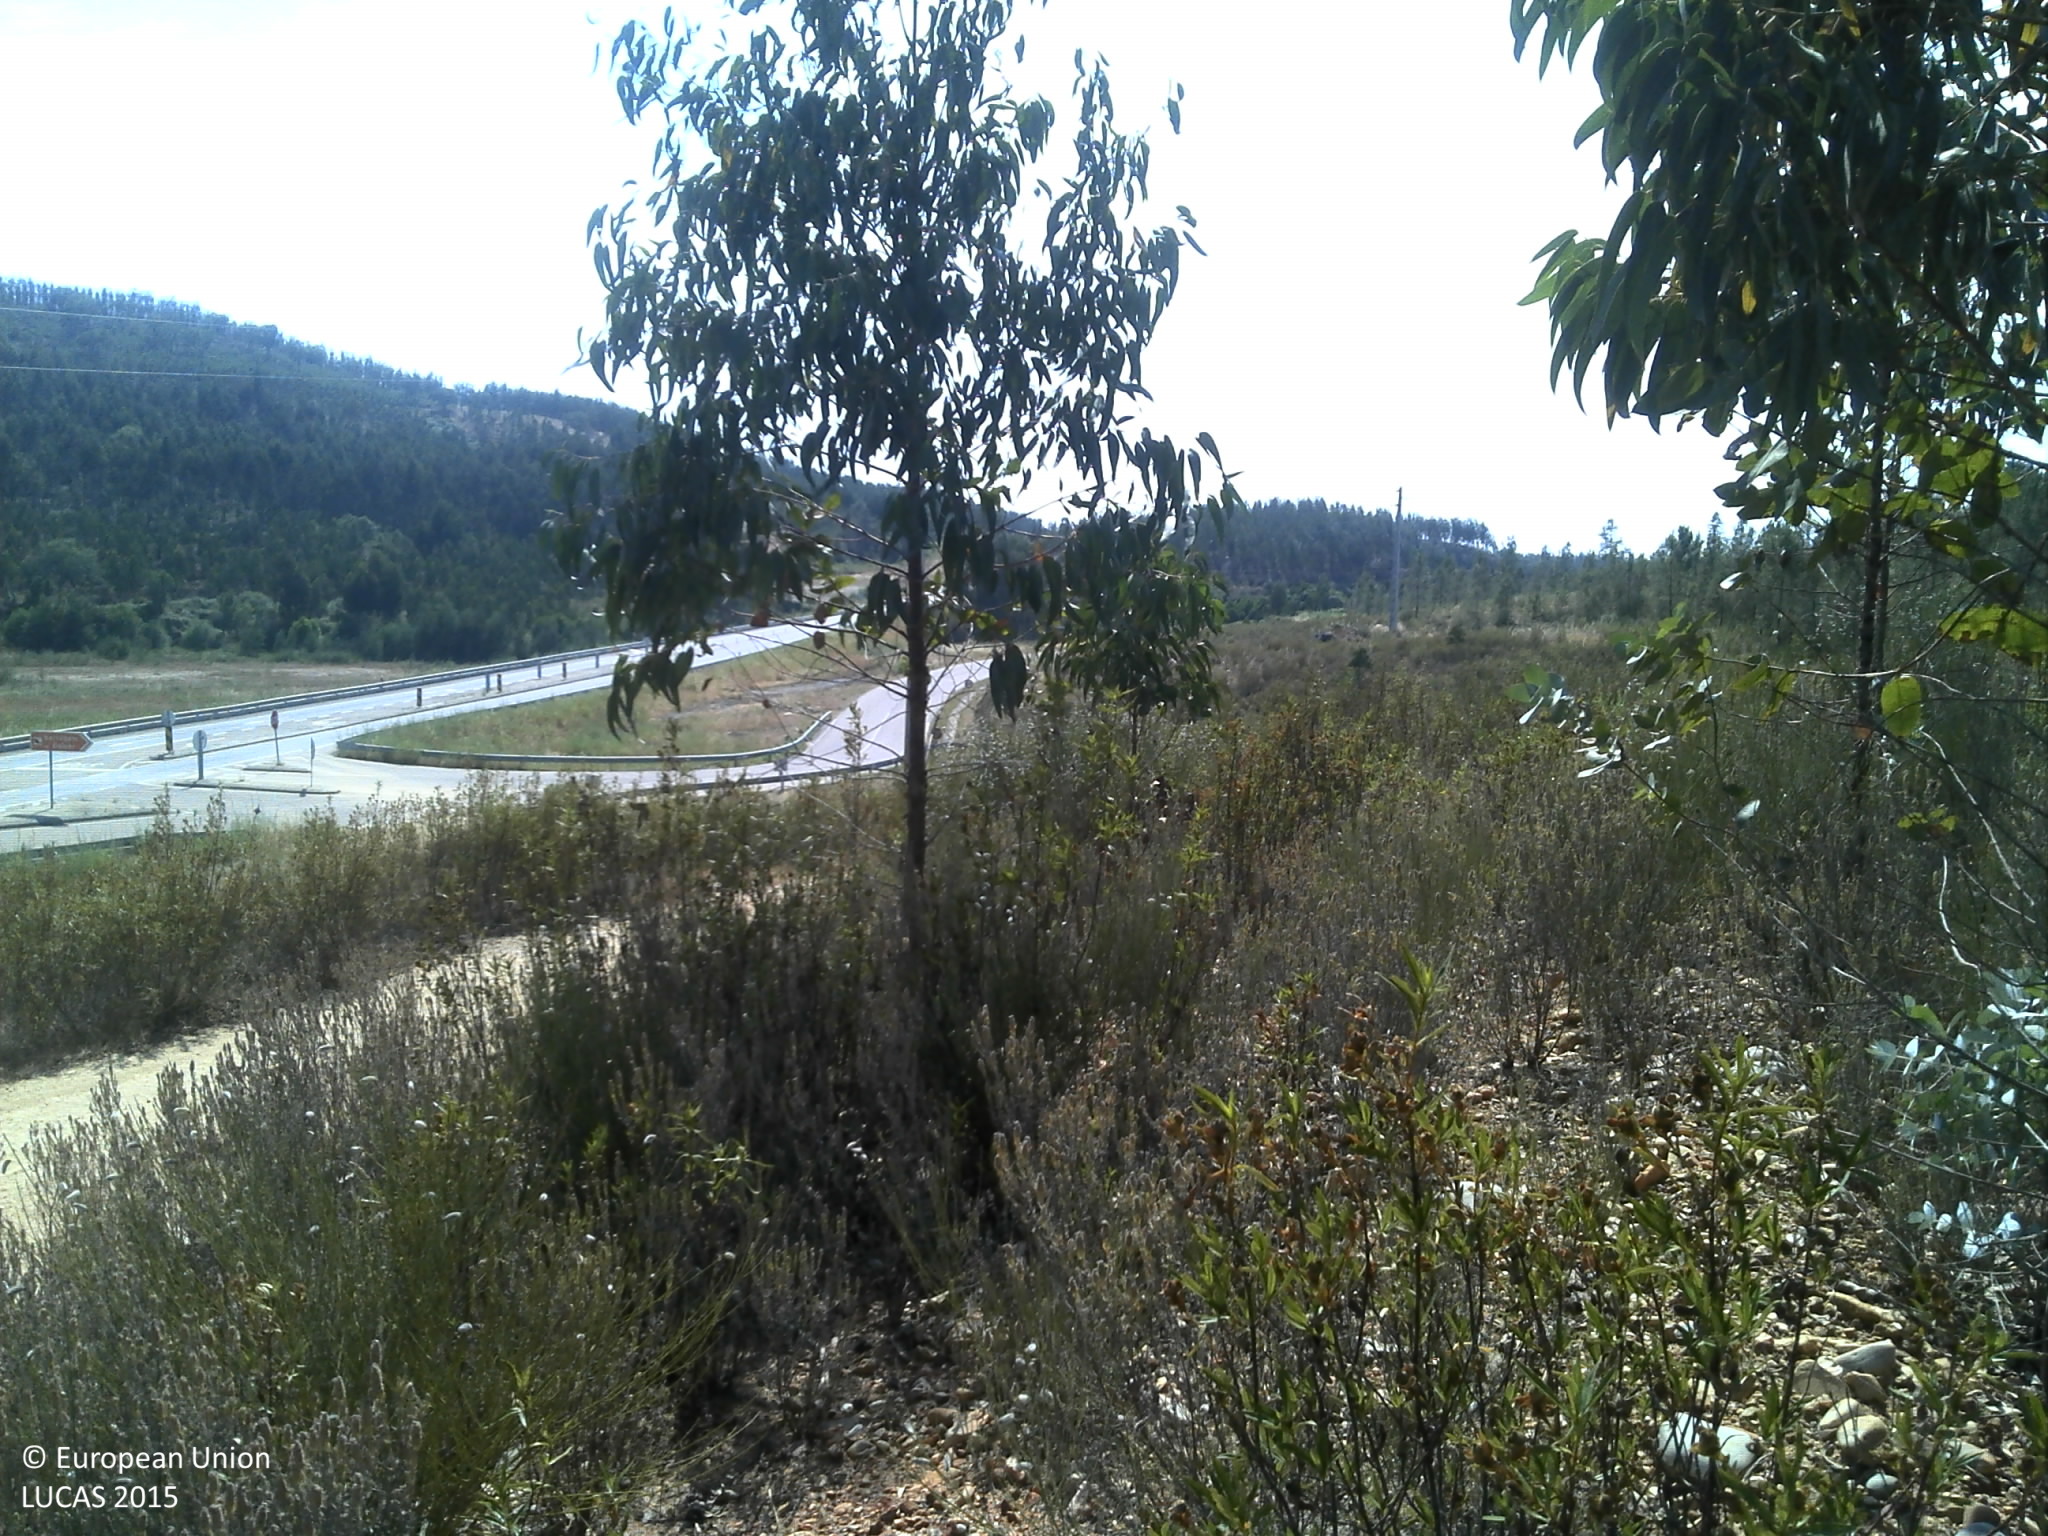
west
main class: Woodland
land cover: Broadleaved woodland
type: exotic forest
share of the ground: 10 - 25 %
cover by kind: shrubs 50 %, broadleaved forest trees 25 %, unconsolidated bare surface 15 %, herbaceous plants 10 %
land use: Forestry
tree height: < 5 m
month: June
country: PT
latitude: 39.4574
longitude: -7.9907
